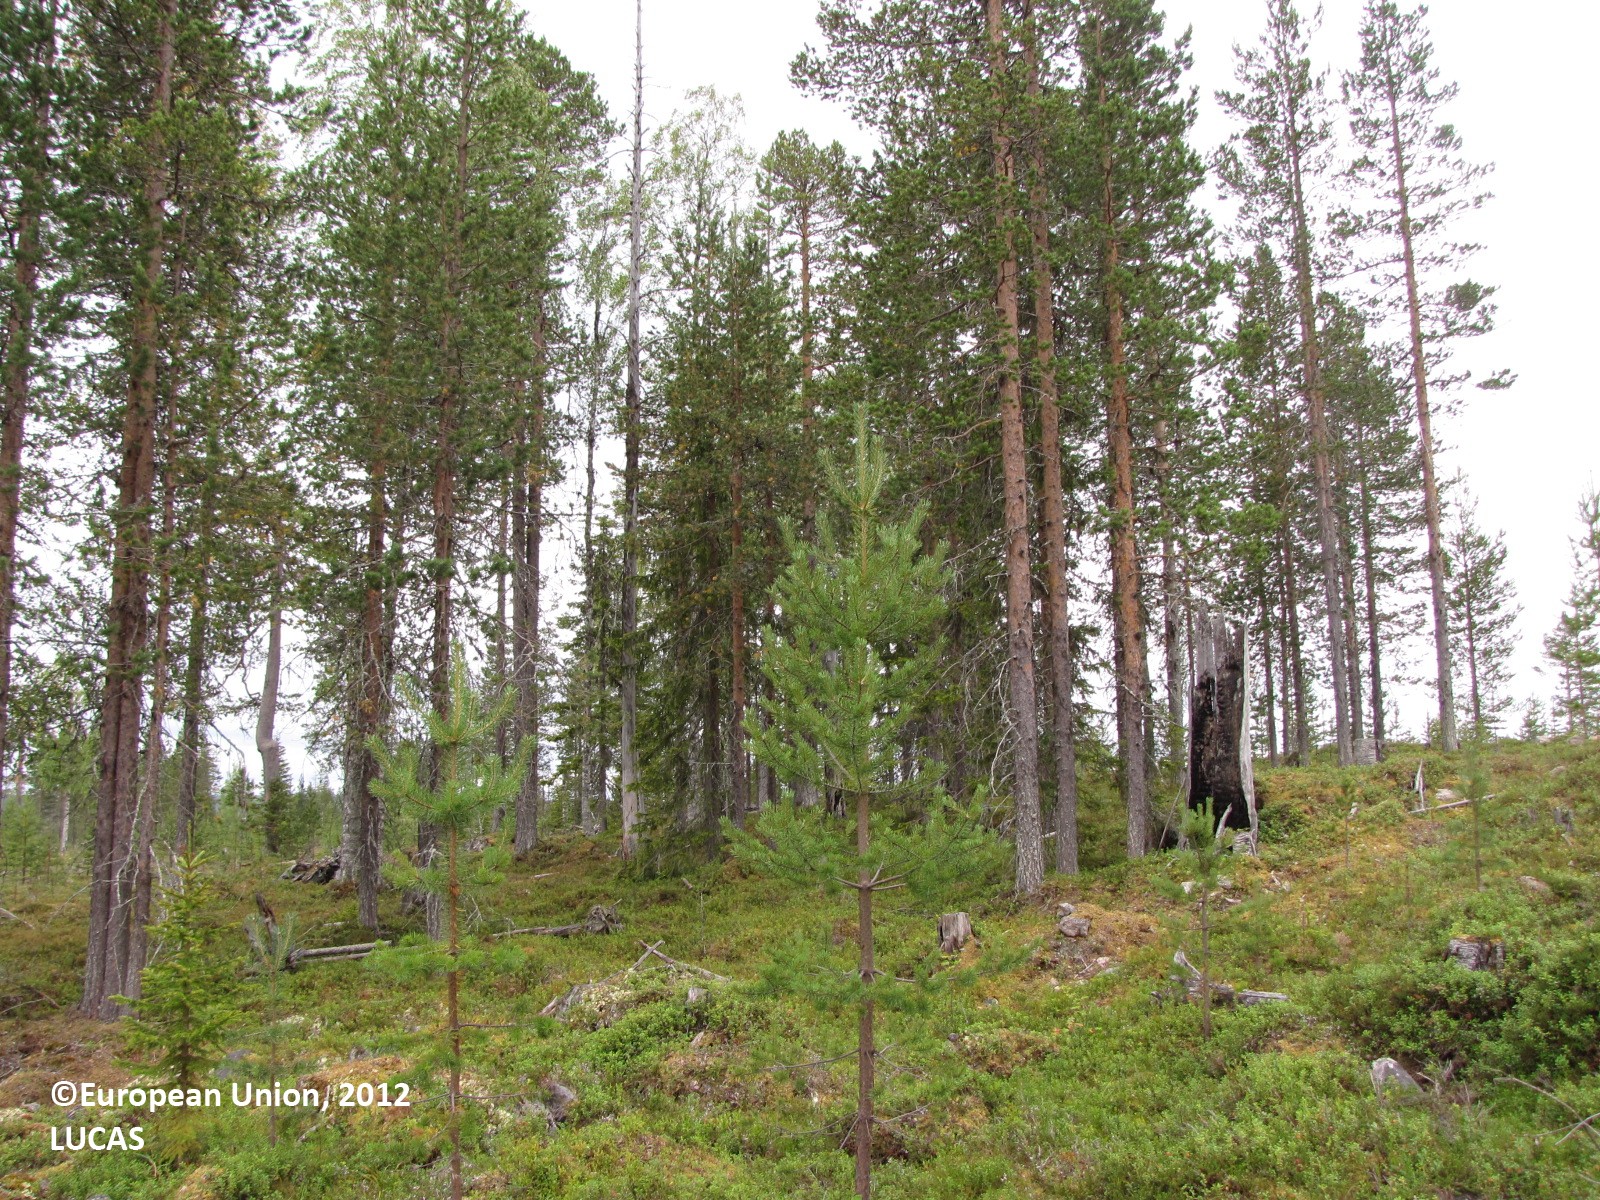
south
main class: Woodland
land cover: Pine dominated mixed woodland
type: boreal forest
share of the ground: 25 - 50 %
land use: Forestry
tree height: > 5 m
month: August
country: FI
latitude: 67.0910
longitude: 25.3143
